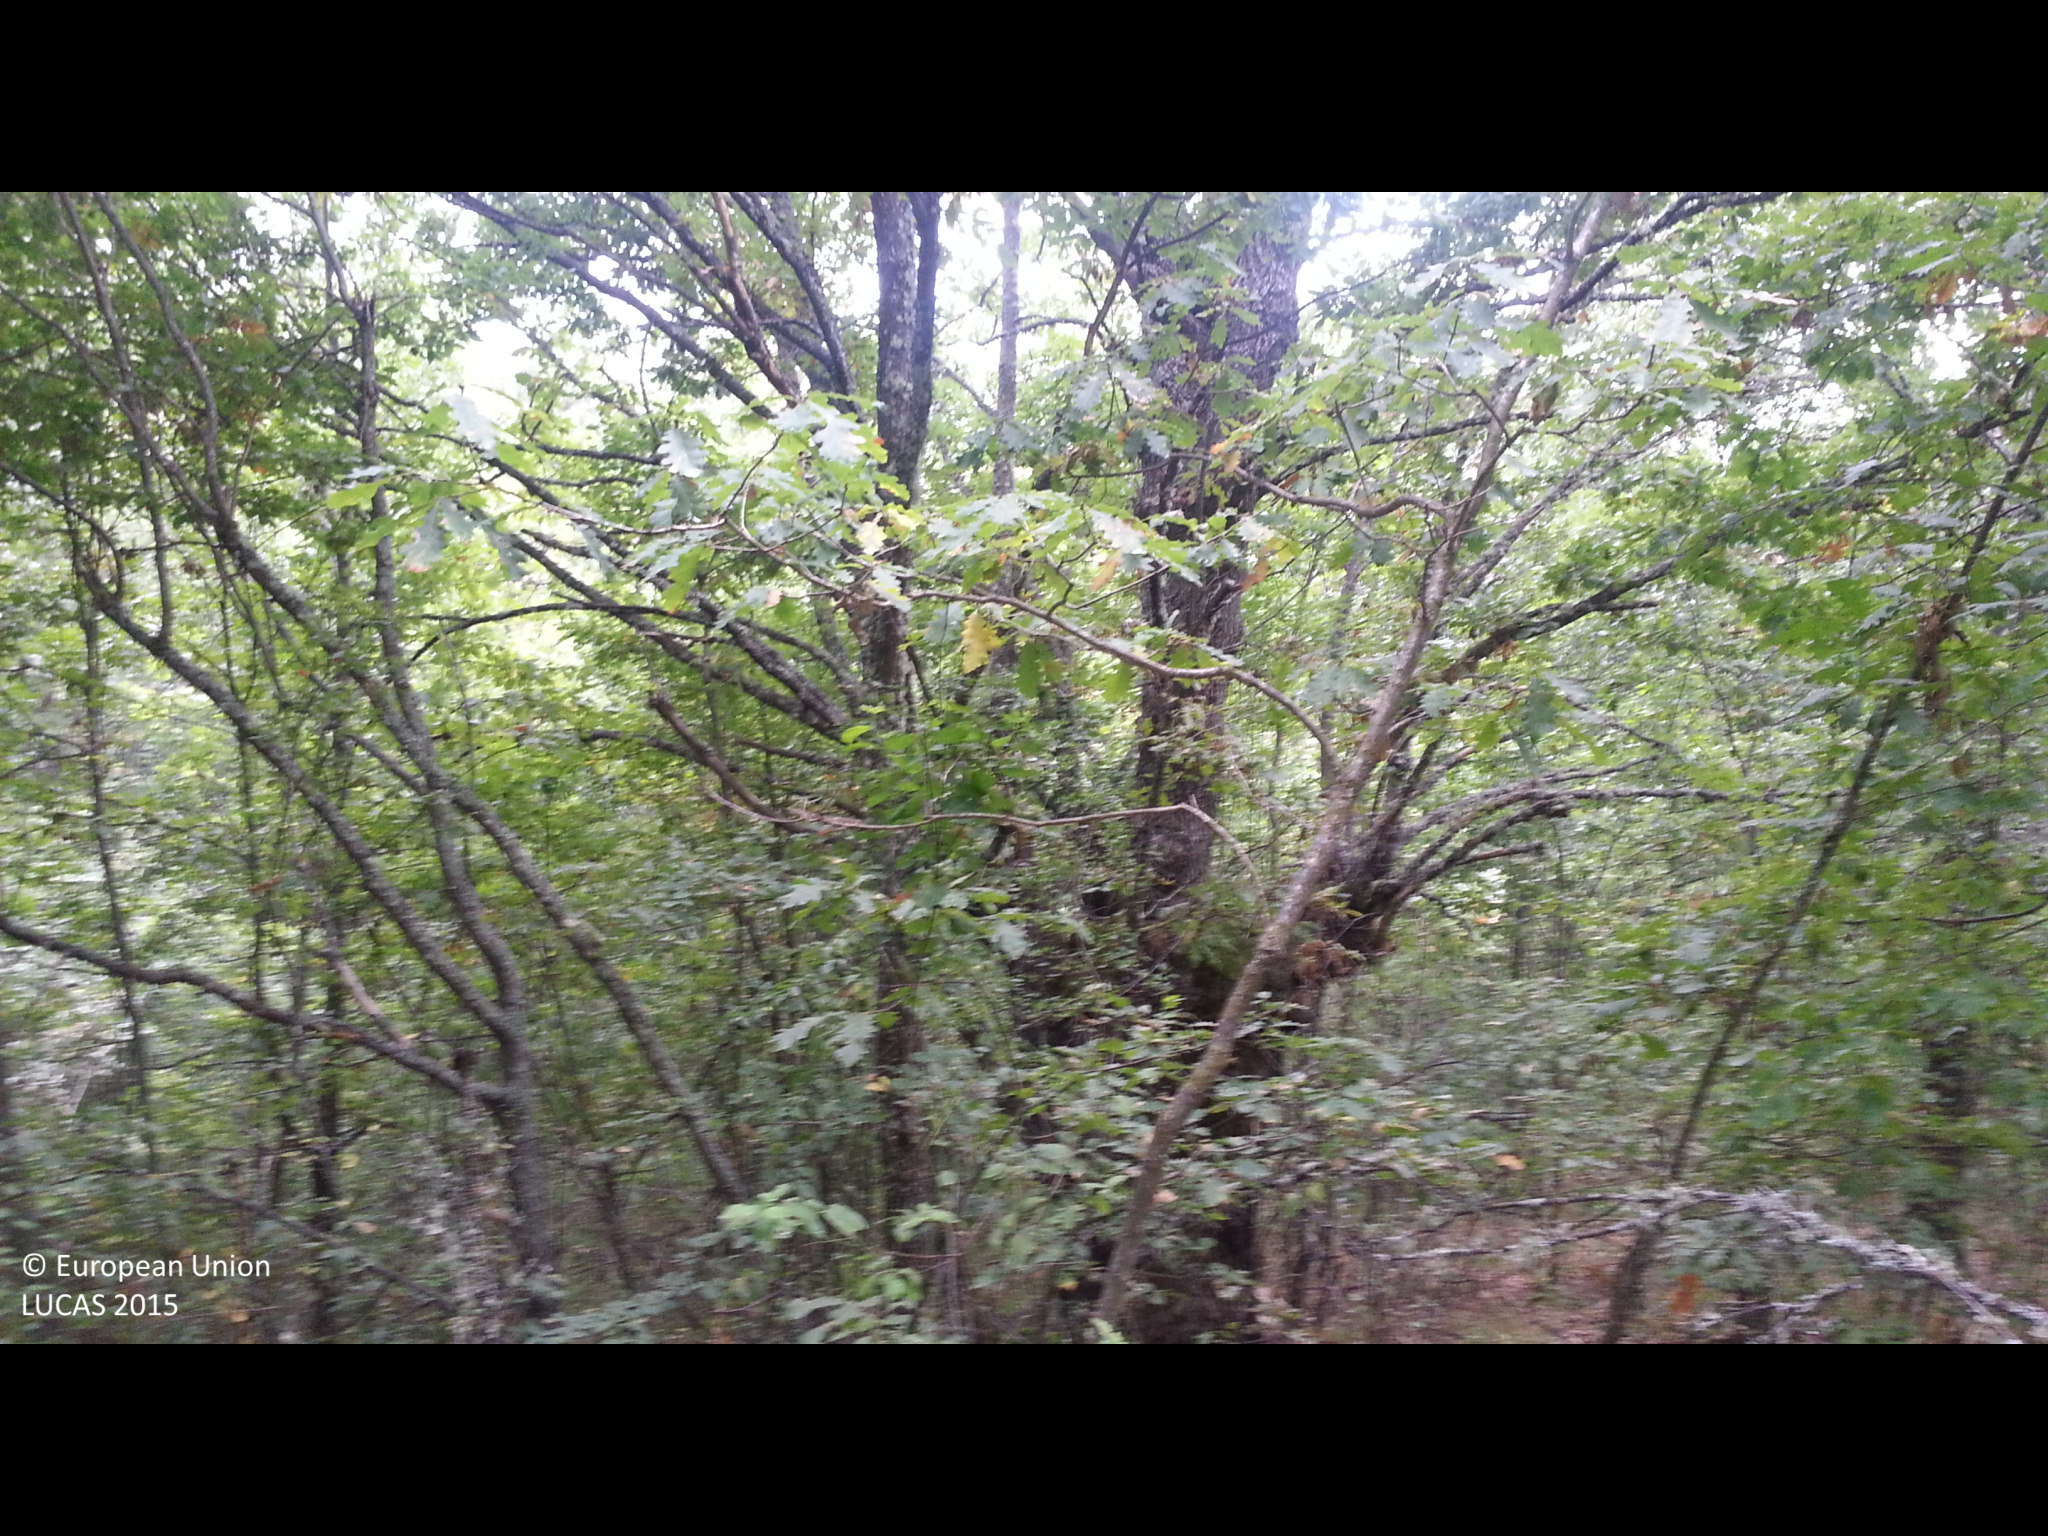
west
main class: Woodland
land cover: Broadleaved woodland
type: mesophytic deciduous forest
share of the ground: > 75 %
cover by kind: broadleaved forest trees 90 %, shrubs 10 %
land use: Forestry
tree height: > 5 m
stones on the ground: < 10 %
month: September
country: BG
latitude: 42.3643
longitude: 22.5393
